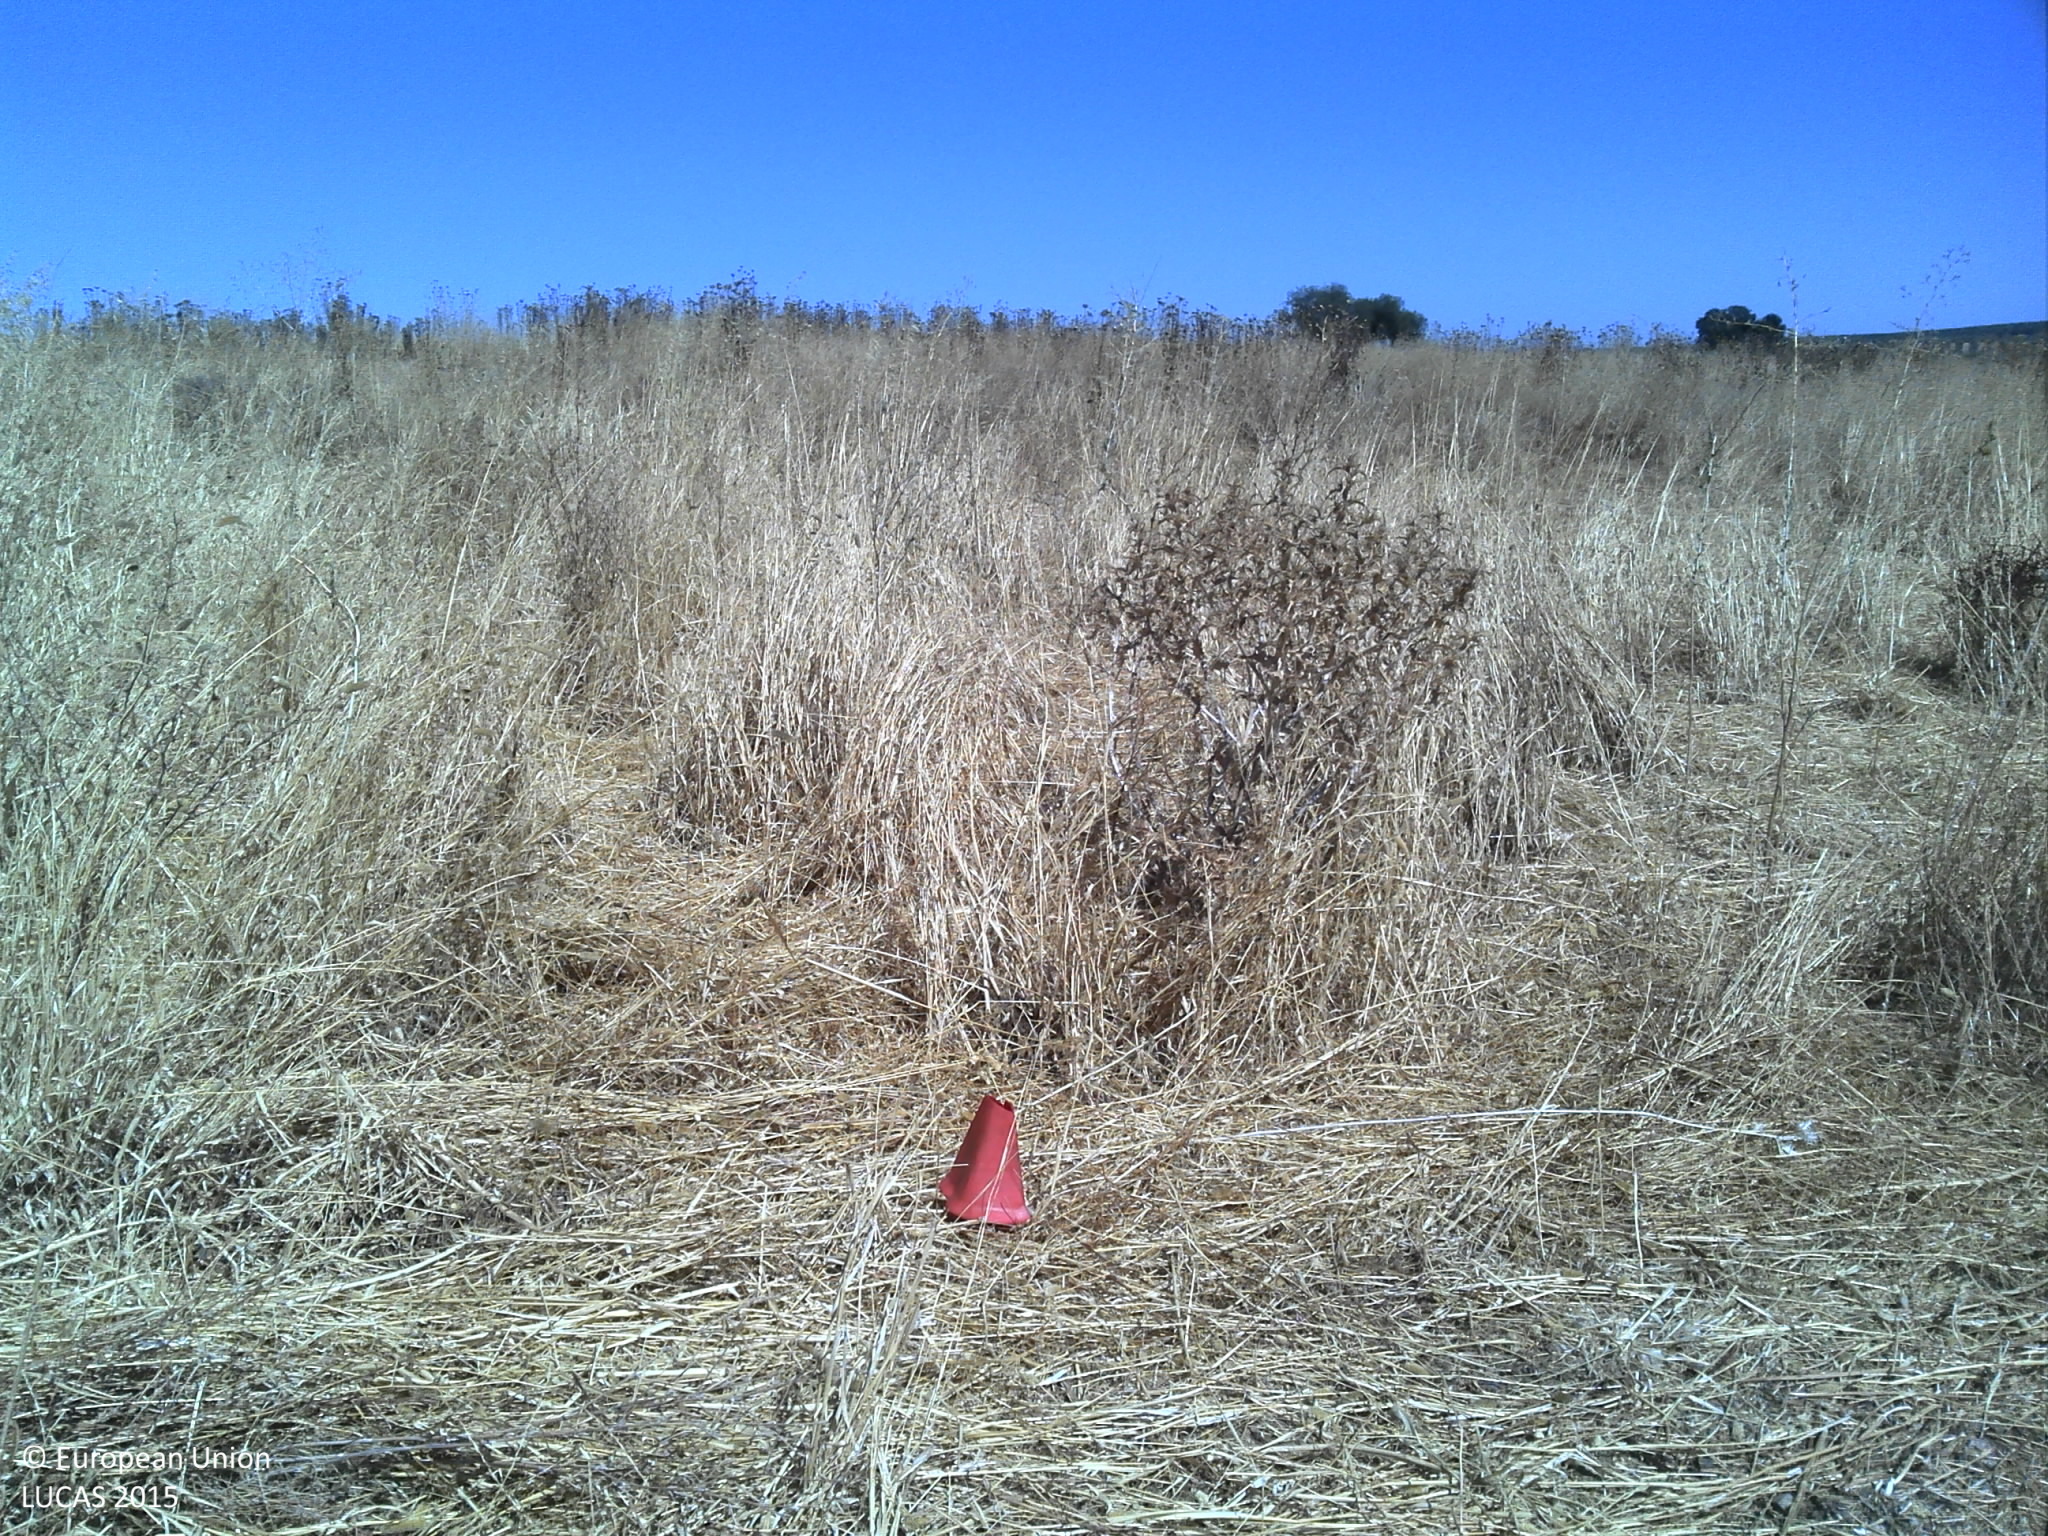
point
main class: Grassland
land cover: Grassland without tree/shrub cover
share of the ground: > 75 %
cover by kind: herbaceous plants 85 %, unconsolidated bare surface 15 %
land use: Agriculture (excluding fallow land and kitchen gardens)
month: July
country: PT
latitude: 38.1577
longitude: -7.7281
